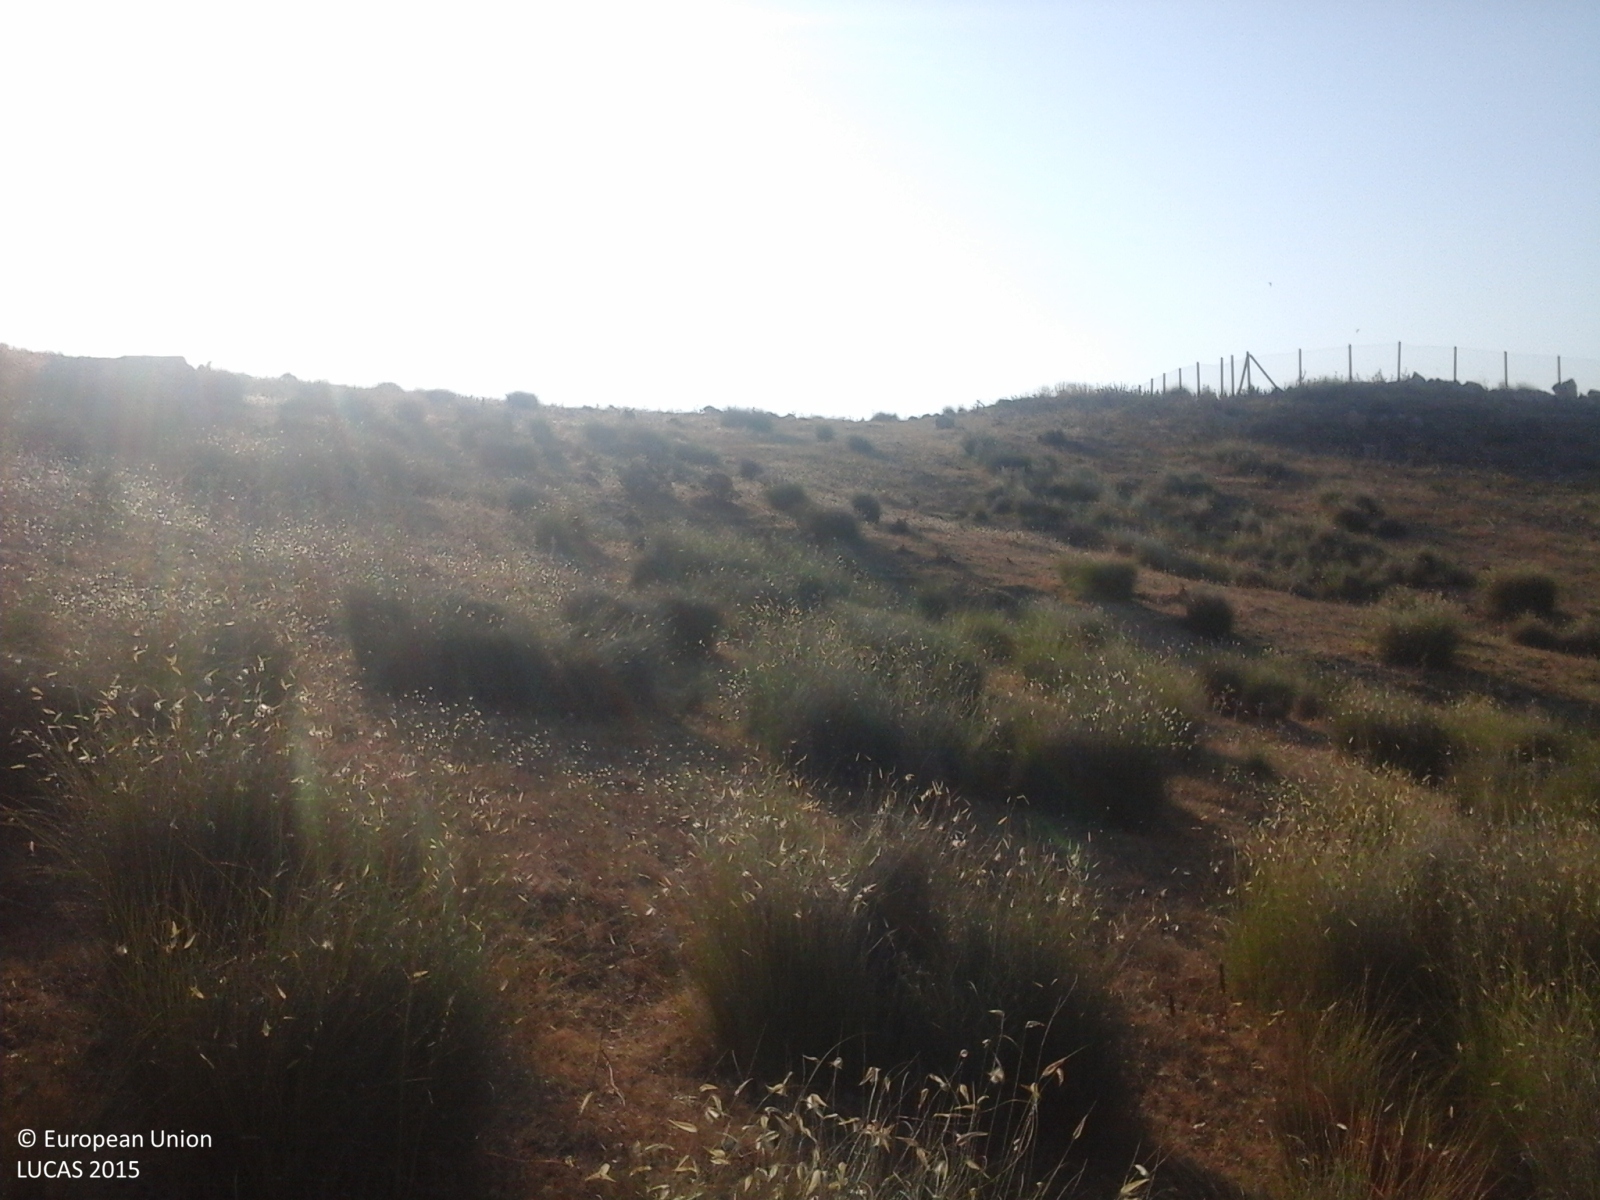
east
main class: Grassland
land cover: Grassland without tree/shrub cover
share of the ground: > 75 %
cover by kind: herbaceous plants 100 %
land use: Semi-natural and natural areas not in use
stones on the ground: < 10 %
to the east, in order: Grassland without tree/shrub cover; Tracks; Fences; Olive groves
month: July
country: IT
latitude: 37.1176
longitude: 14.0086
